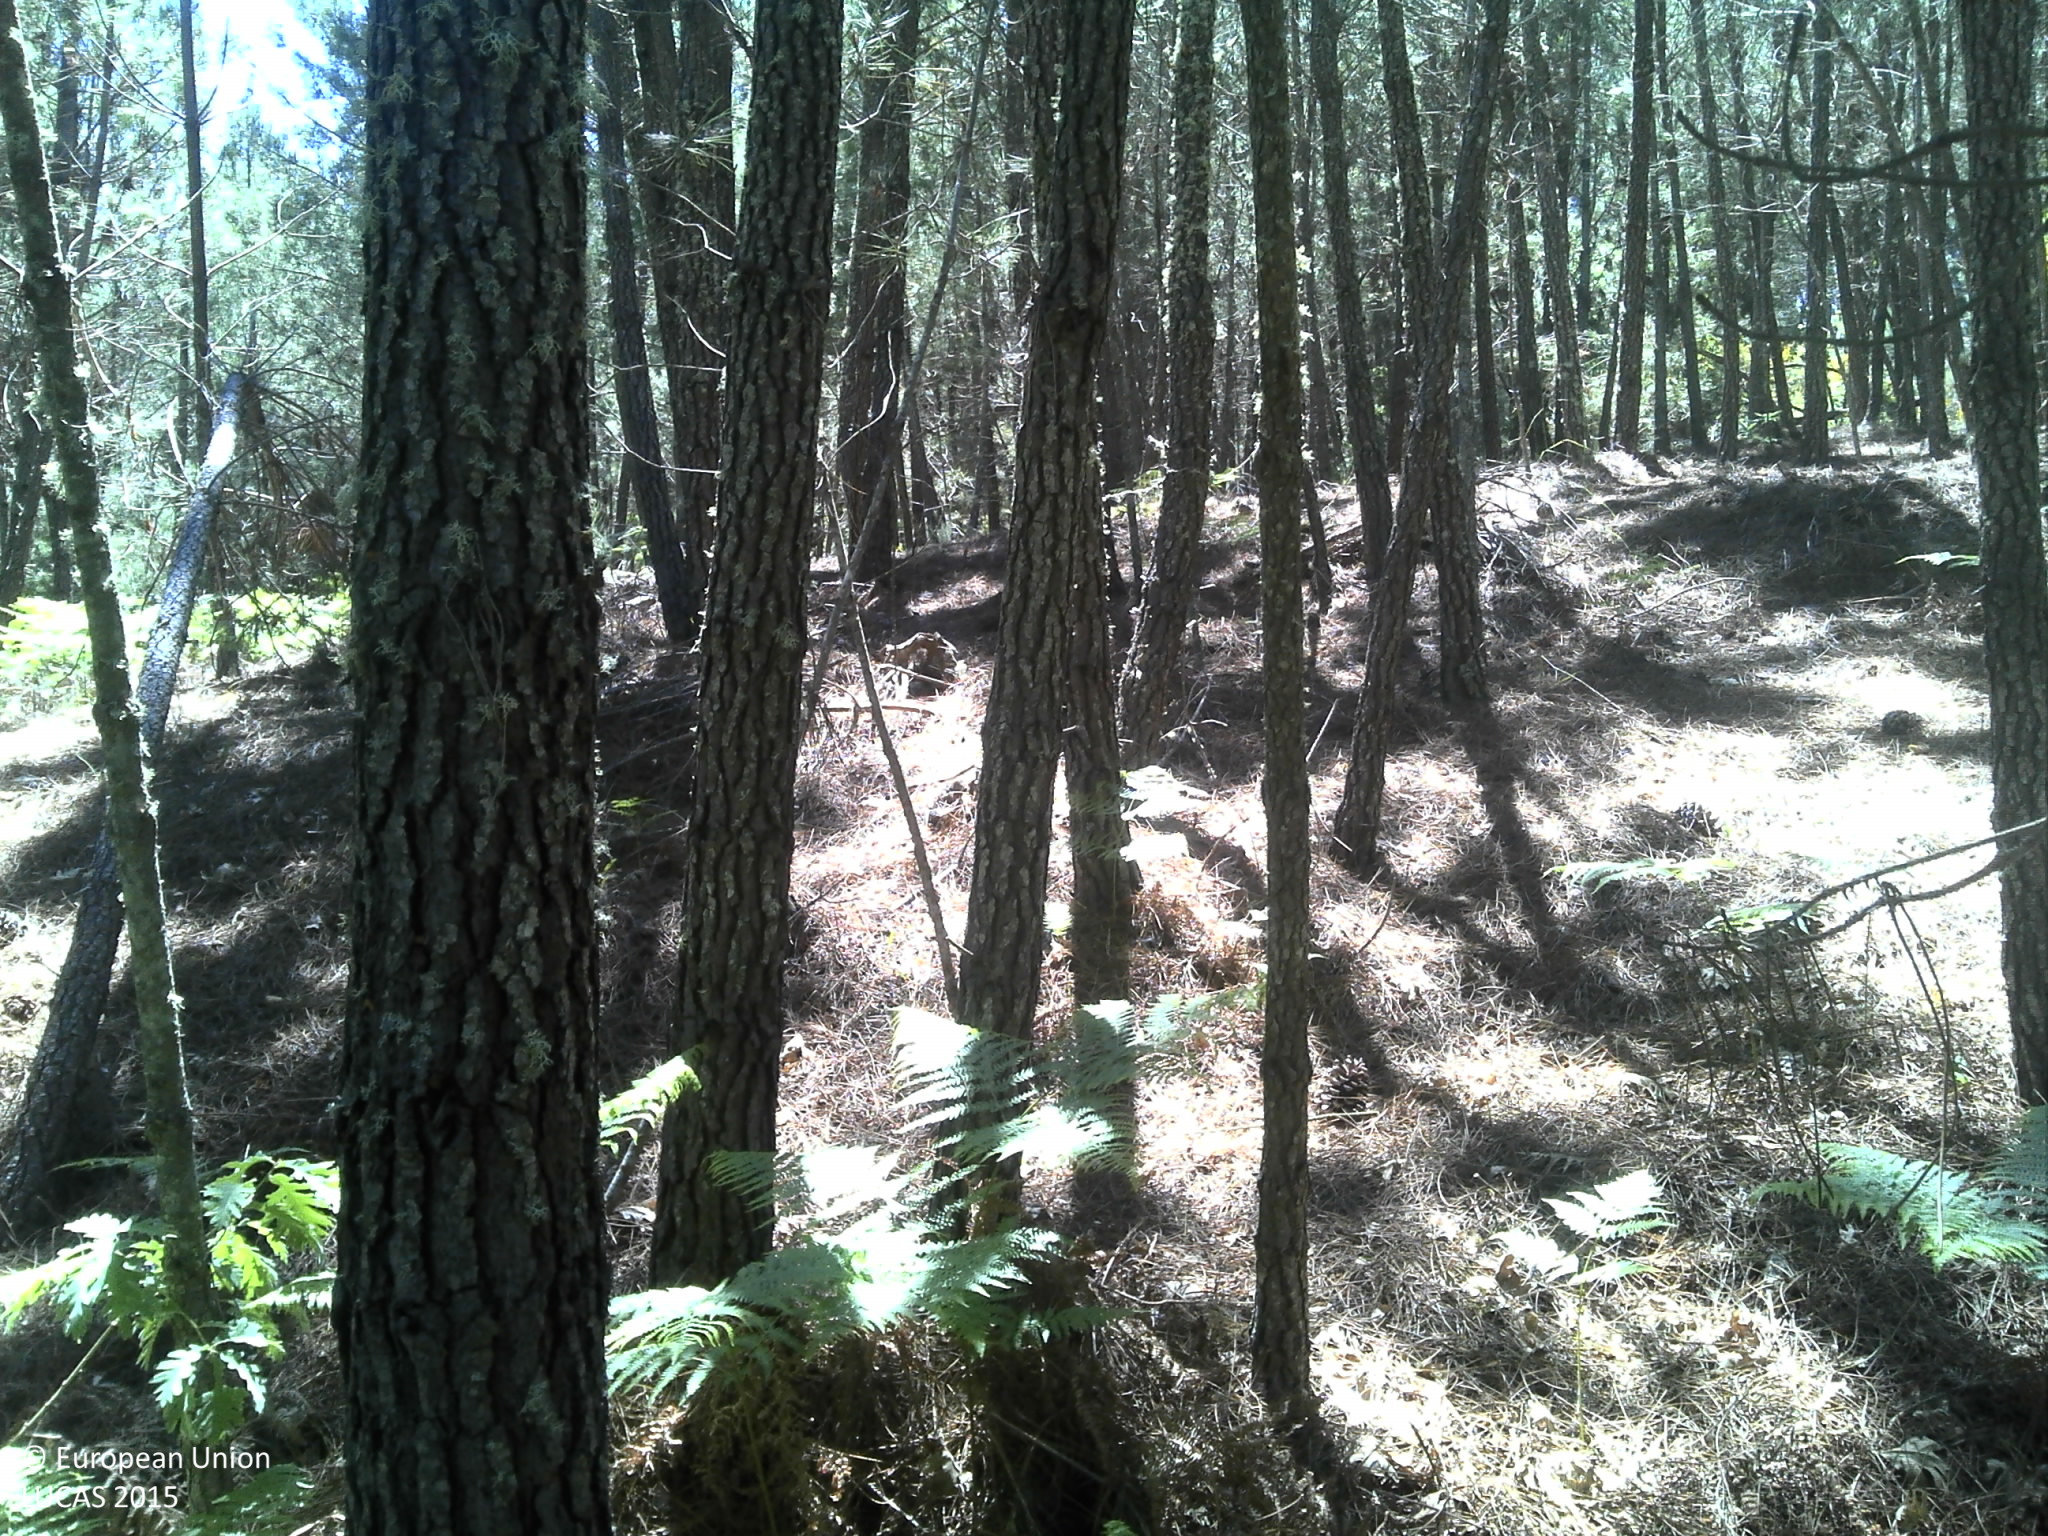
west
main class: Woodland
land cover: Pine dominated coniferous woodland
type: coniferous forest of the mediterranean region
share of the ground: 50 - 75 %
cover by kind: coniferous forest trees 75 %, unconsolidated bare surface 20 %, herbaceous plants 5 %
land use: Forestry
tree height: > 5 m
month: May
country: PT
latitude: 40.5014
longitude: -7.2261
